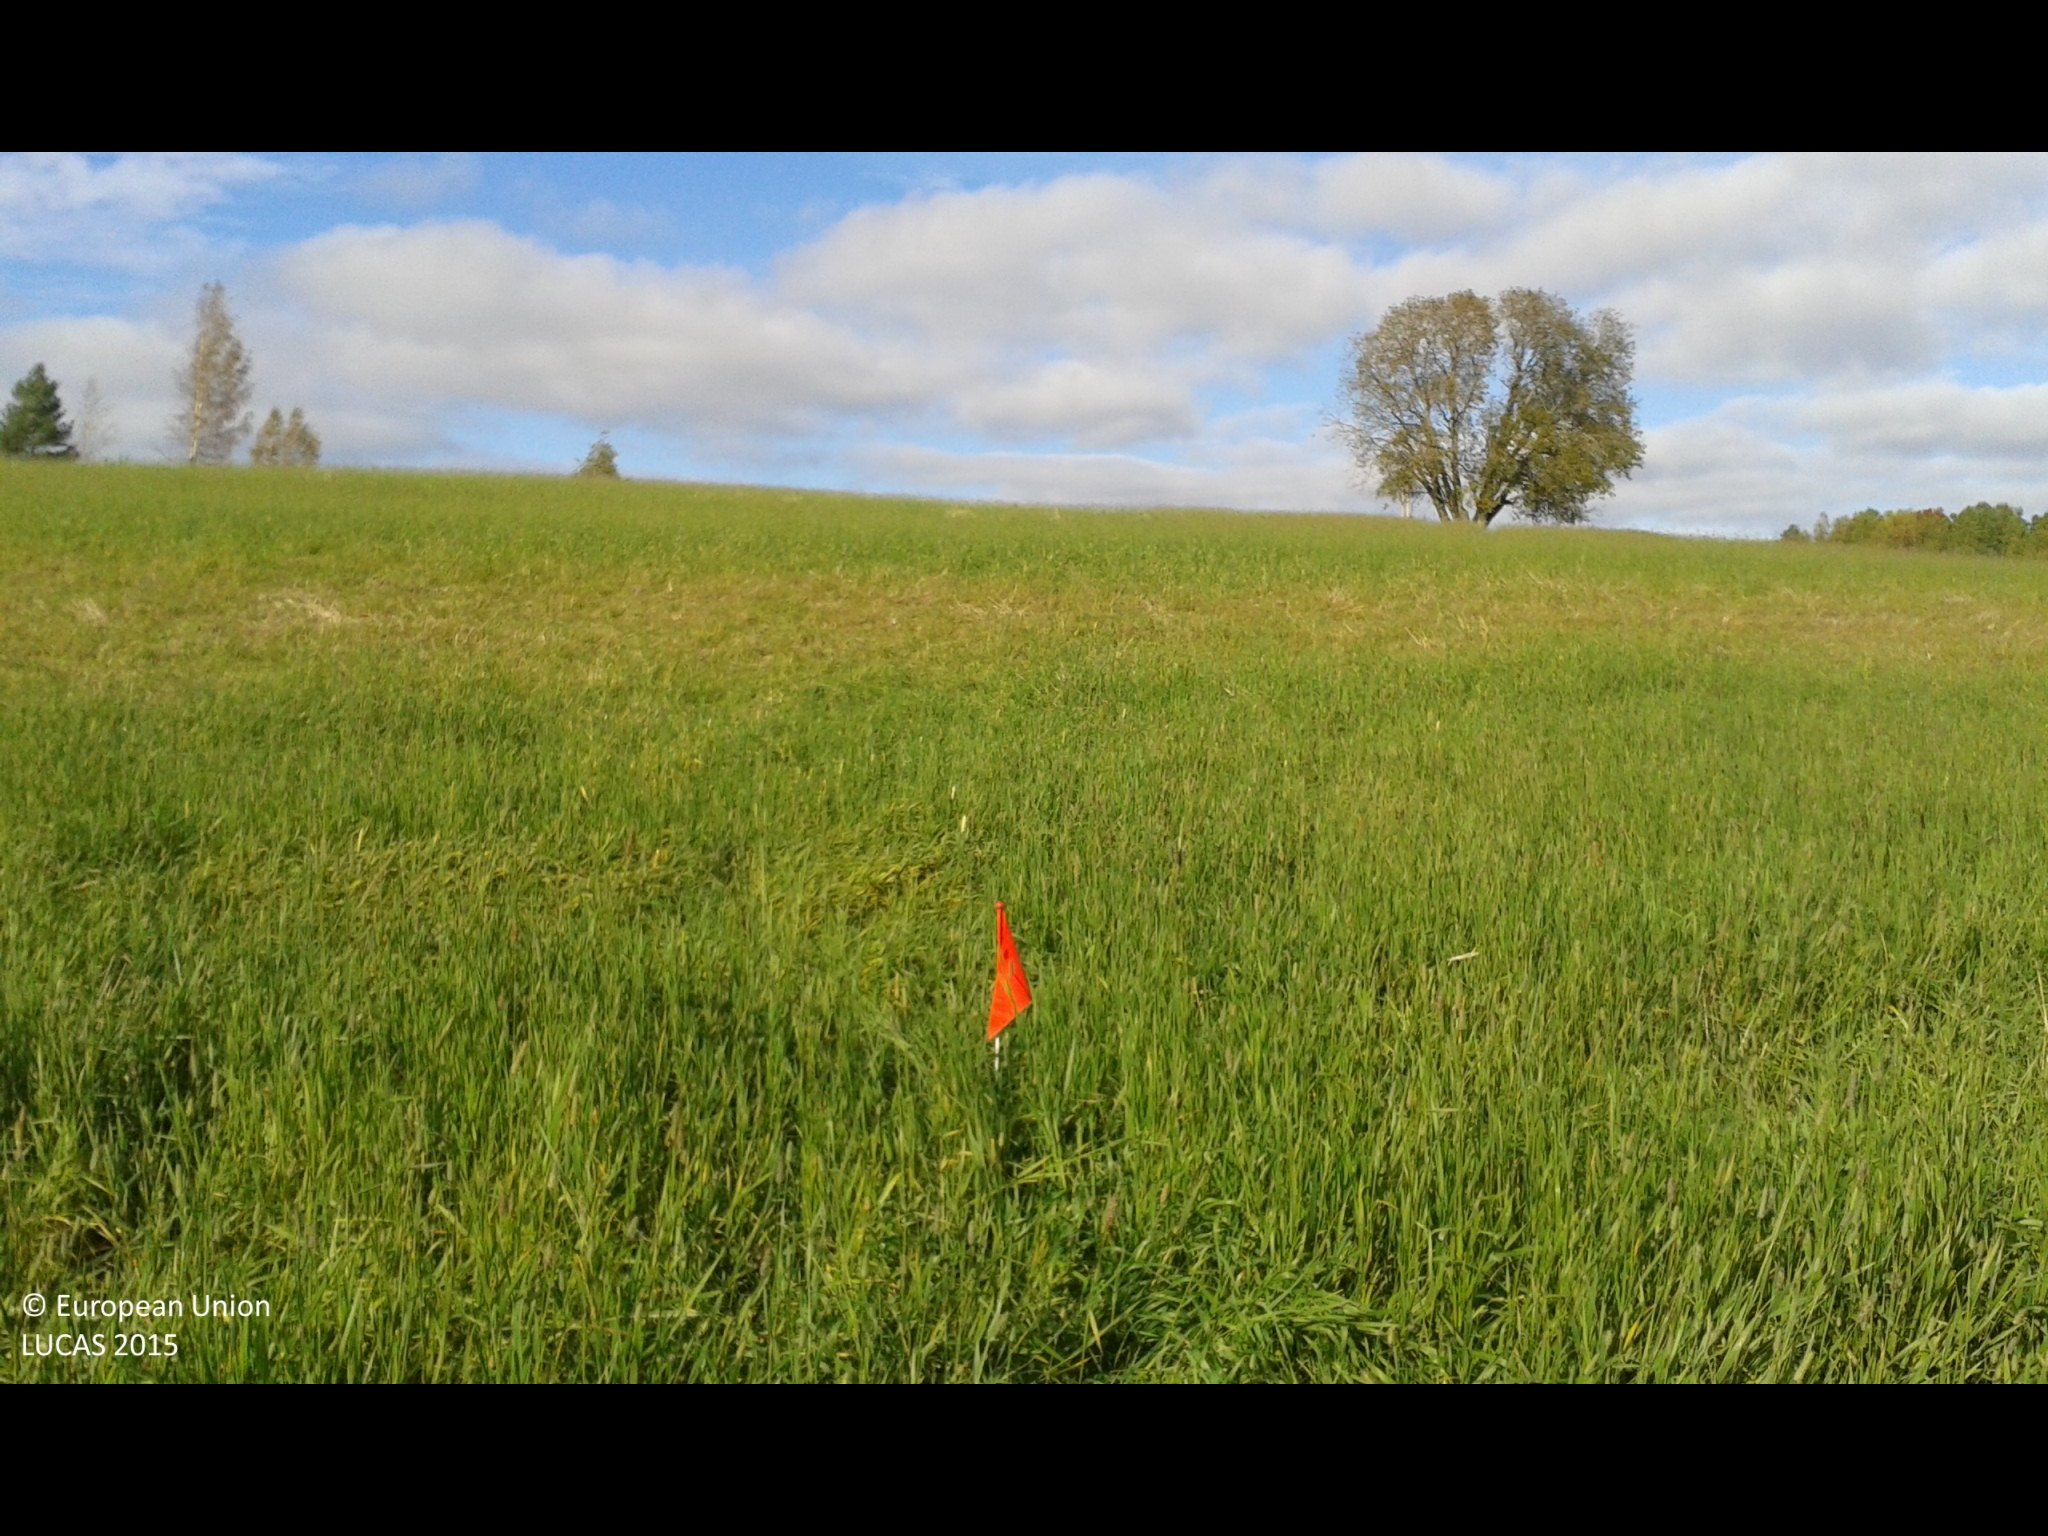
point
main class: Grassland
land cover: Grassland without tree/shrub cover
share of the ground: > 75 %
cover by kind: herbaceous plants 100 %
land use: Agriculture (excluding fallow land and kitchen gardens)
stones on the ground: < 10 %
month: October
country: SE
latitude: 58.9190
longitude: 17.0645
